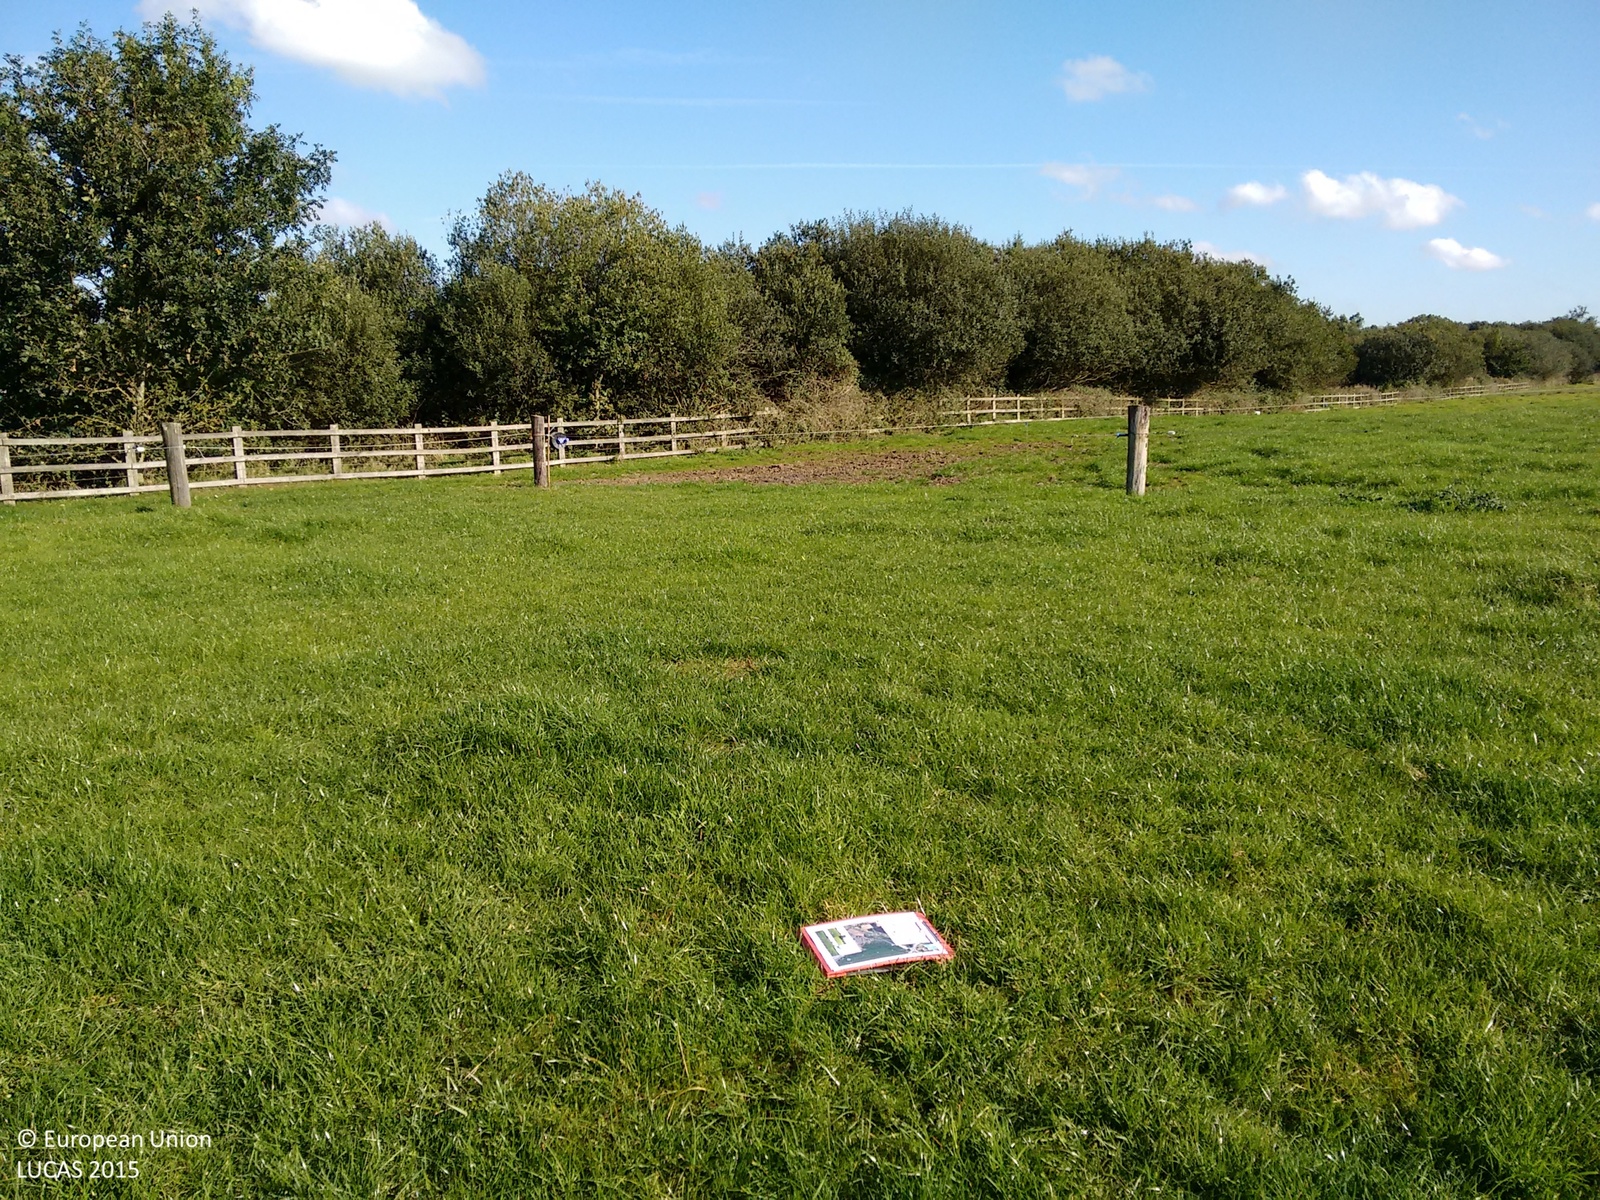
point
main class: Grassland
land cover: Grassland without tree/shrub cover
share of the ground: > 75 %
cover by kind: herbaceous plants 100 %
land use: Agriculture (excluding fallow land and kitchen gardens)
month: September
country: GB
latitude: 52.5258
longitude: 1.0304
